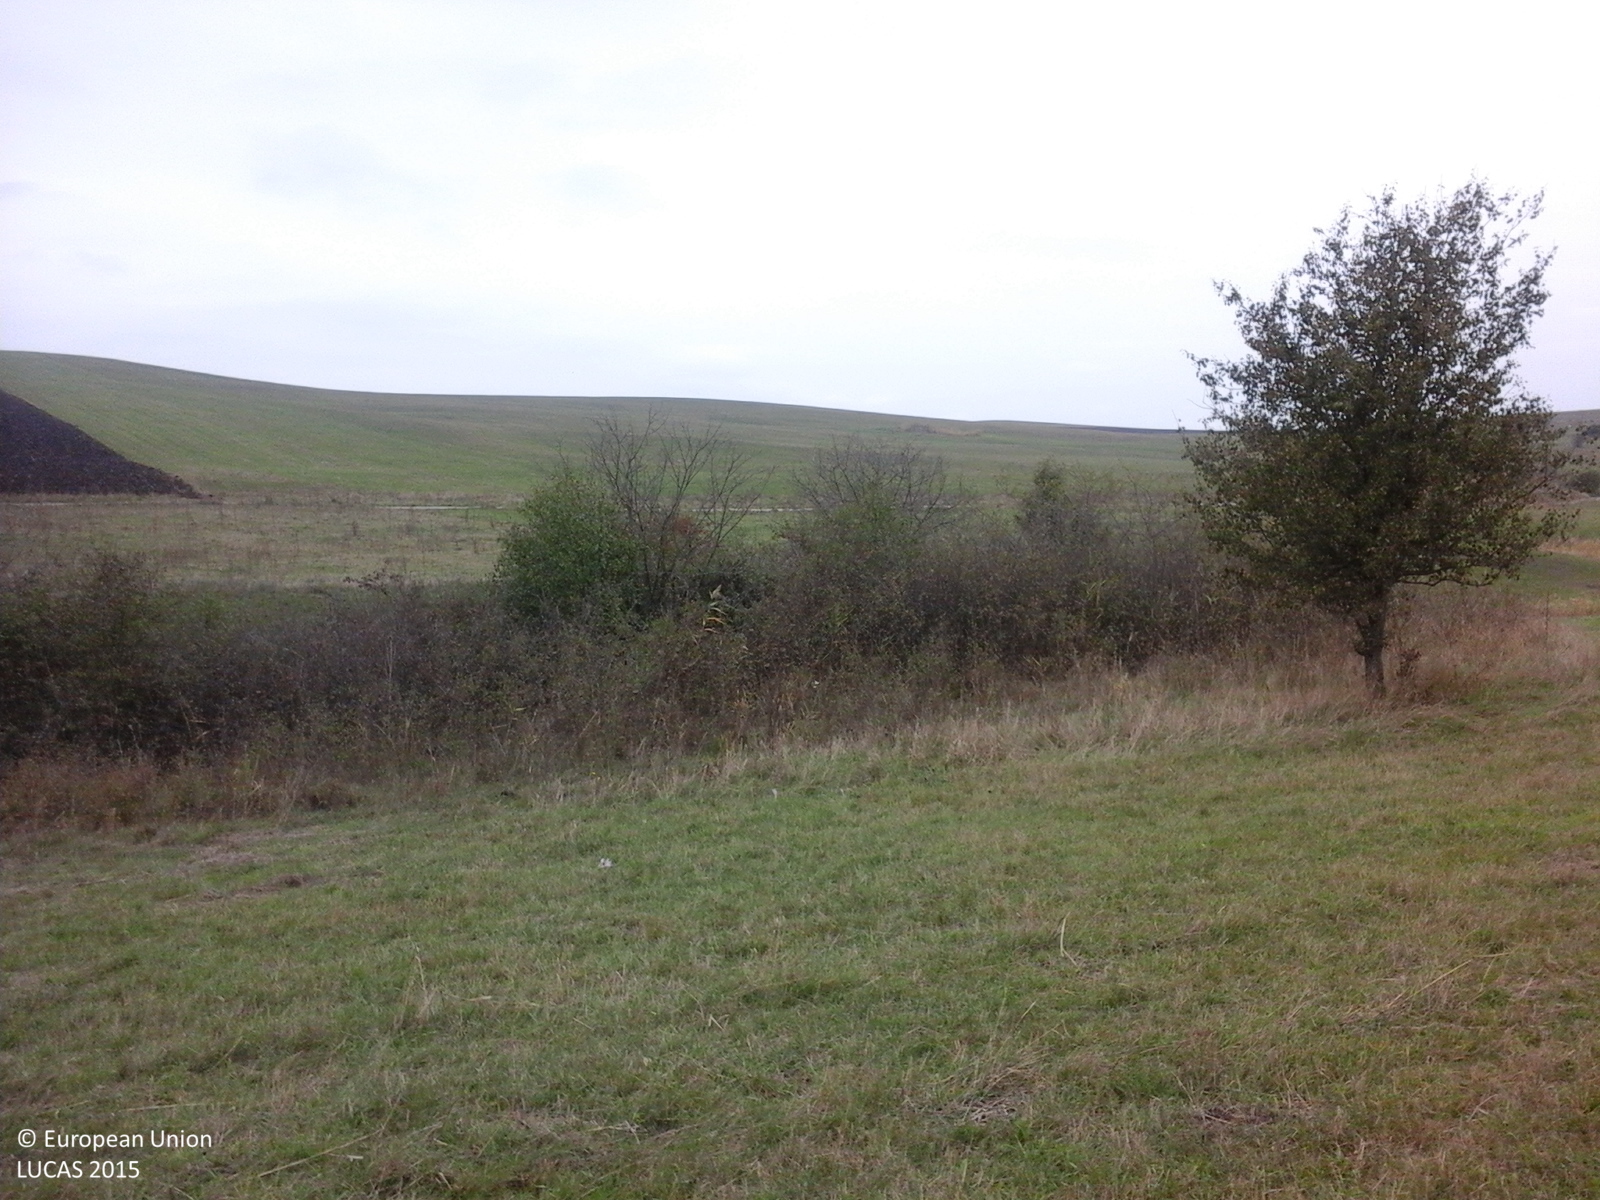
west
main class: Grassland
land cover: Grassland without tree/shrub cover
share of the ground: > 75 %
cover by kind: herbaceous plants 100 %
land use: Agriculture (excluding fallow land and kitchen gardens)
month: October
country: RO
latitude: 46.1317
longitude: 25.2304
